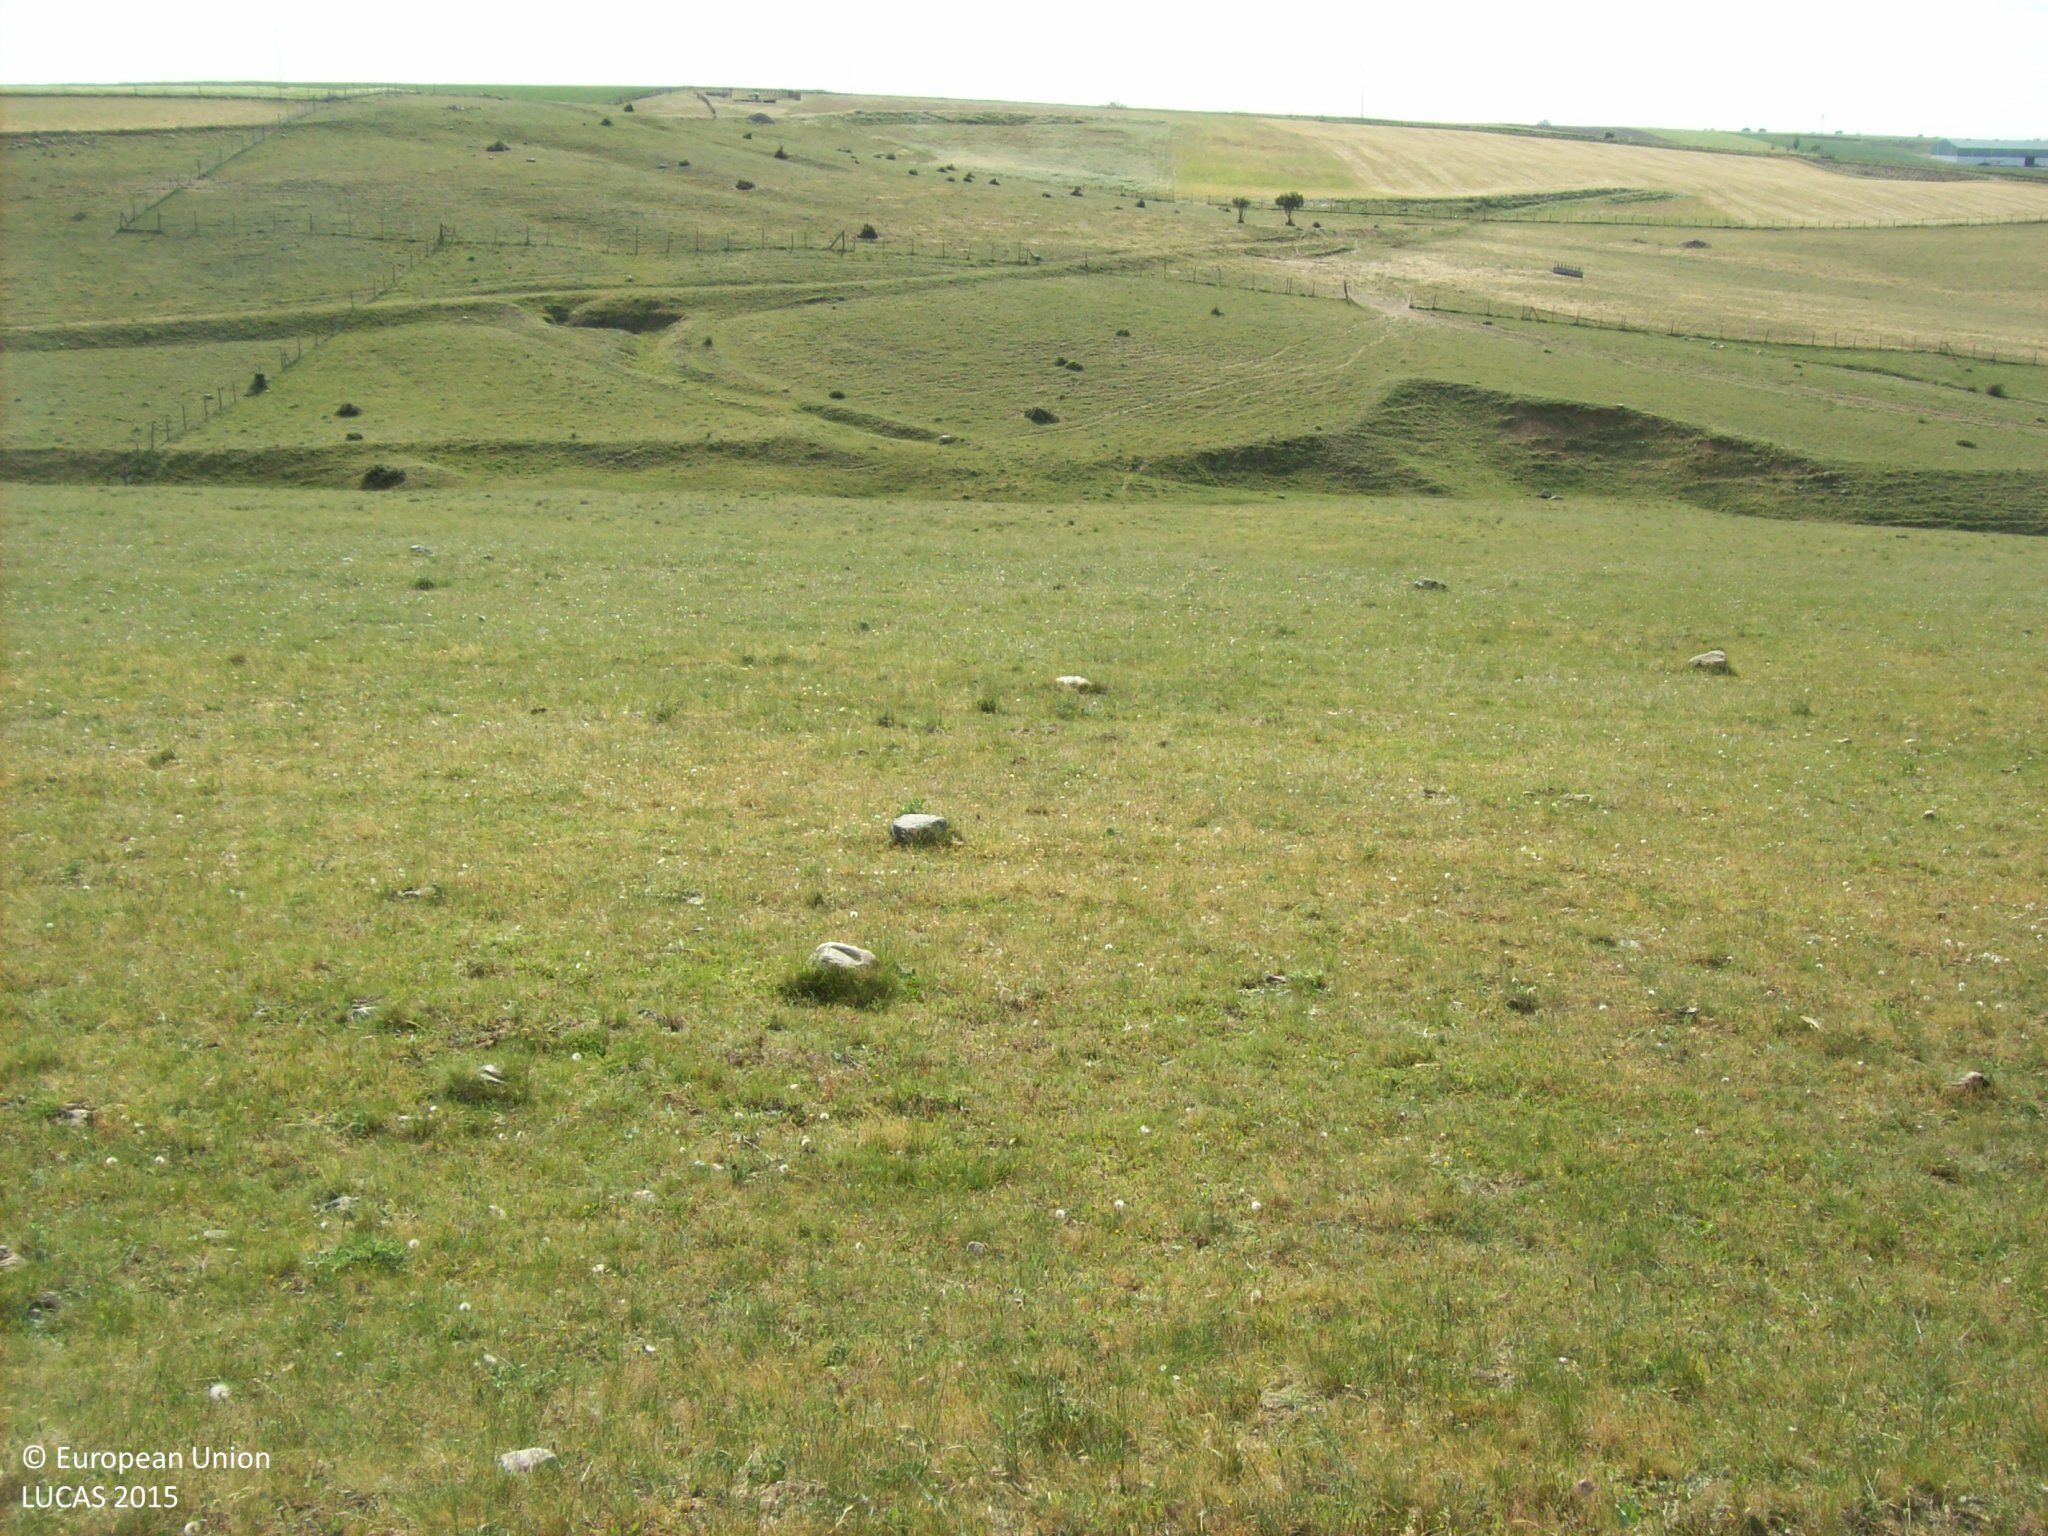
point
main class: Grassland
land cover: Grassland without tree/shrub cover
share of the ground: > 75 %
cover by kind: herbaceous plants 100 %
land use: Agriculture (excluding fallow land and kitchen gardens)
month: May
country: ES
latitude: 40.7976
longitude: -4.5022
